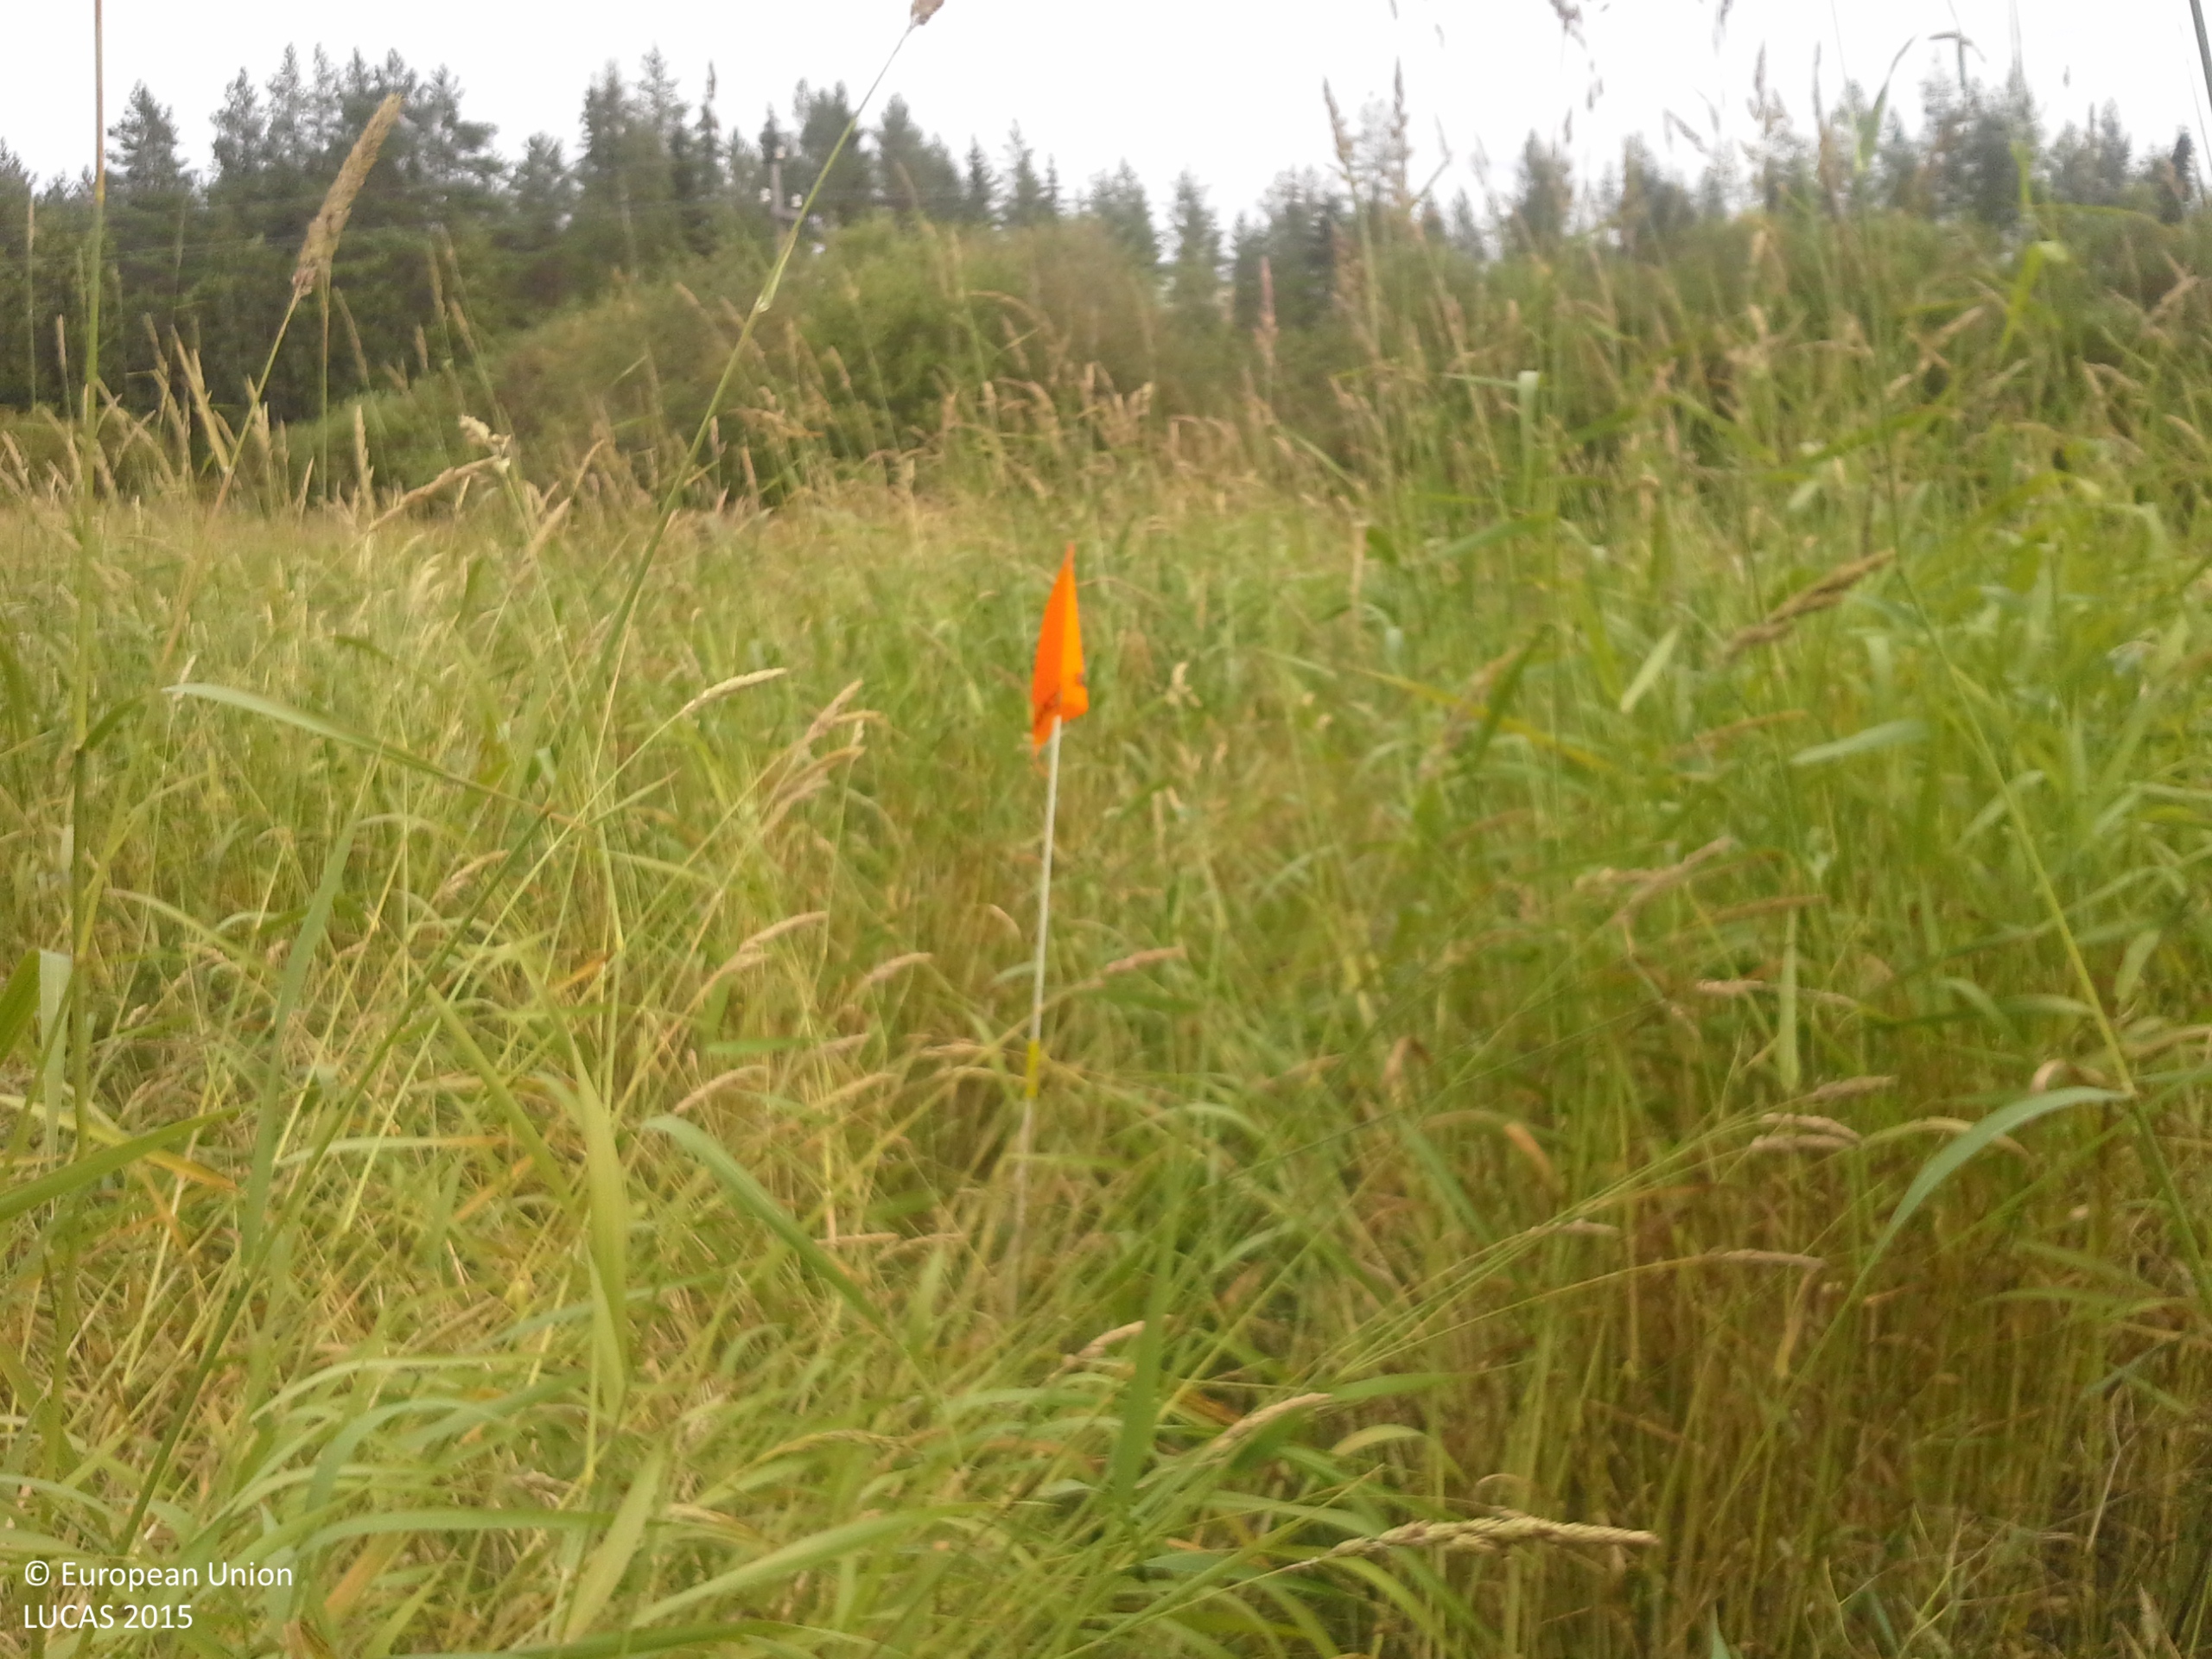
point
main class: Cropland
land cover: Temporary grasslands
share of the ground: > 75 %
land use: Agriculture (excluding fallow land and kitchen gardens)
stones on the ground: < 10 %
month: August
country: FI
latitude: 63.1155
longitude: 22.9210
